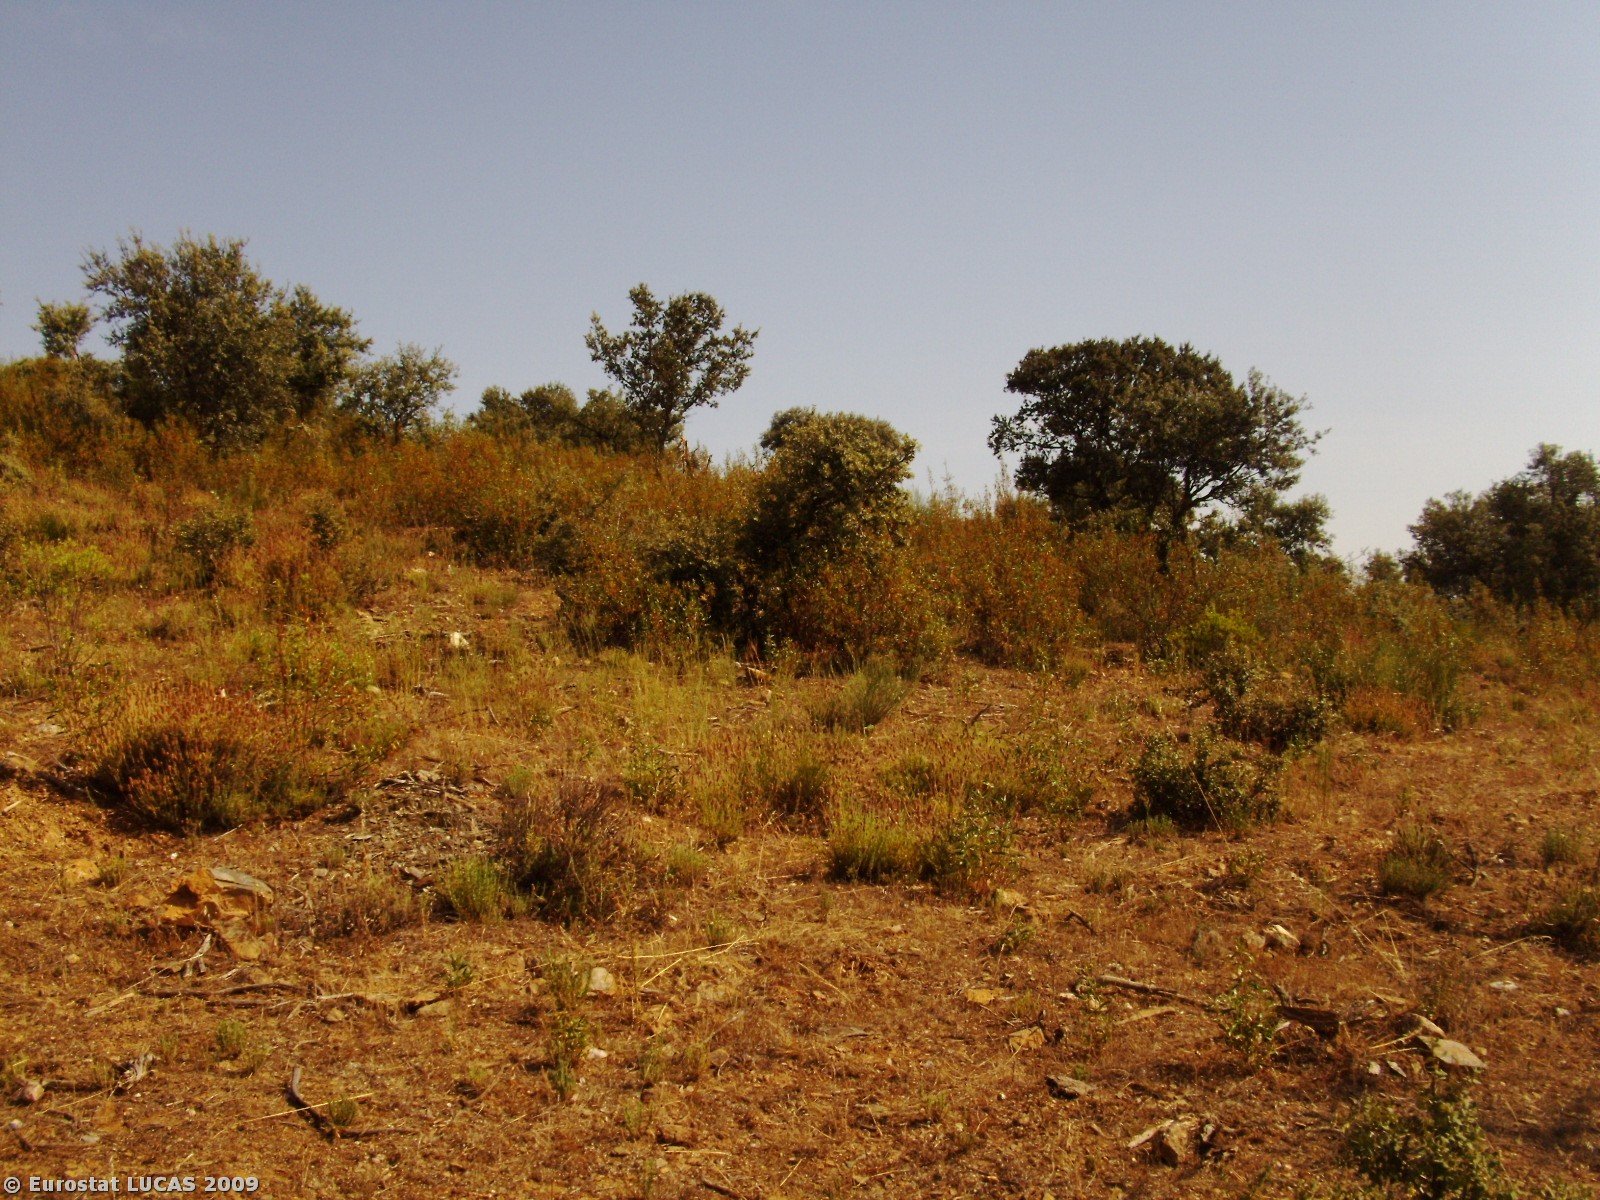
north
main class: Woodland
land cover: Broadleaved woodland
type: broadleaved evergreen forest
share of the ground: 50 - 75 %
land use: Forestry
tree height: > 5 m
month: June
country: PT
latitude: 39.9835
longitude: -7.1319
